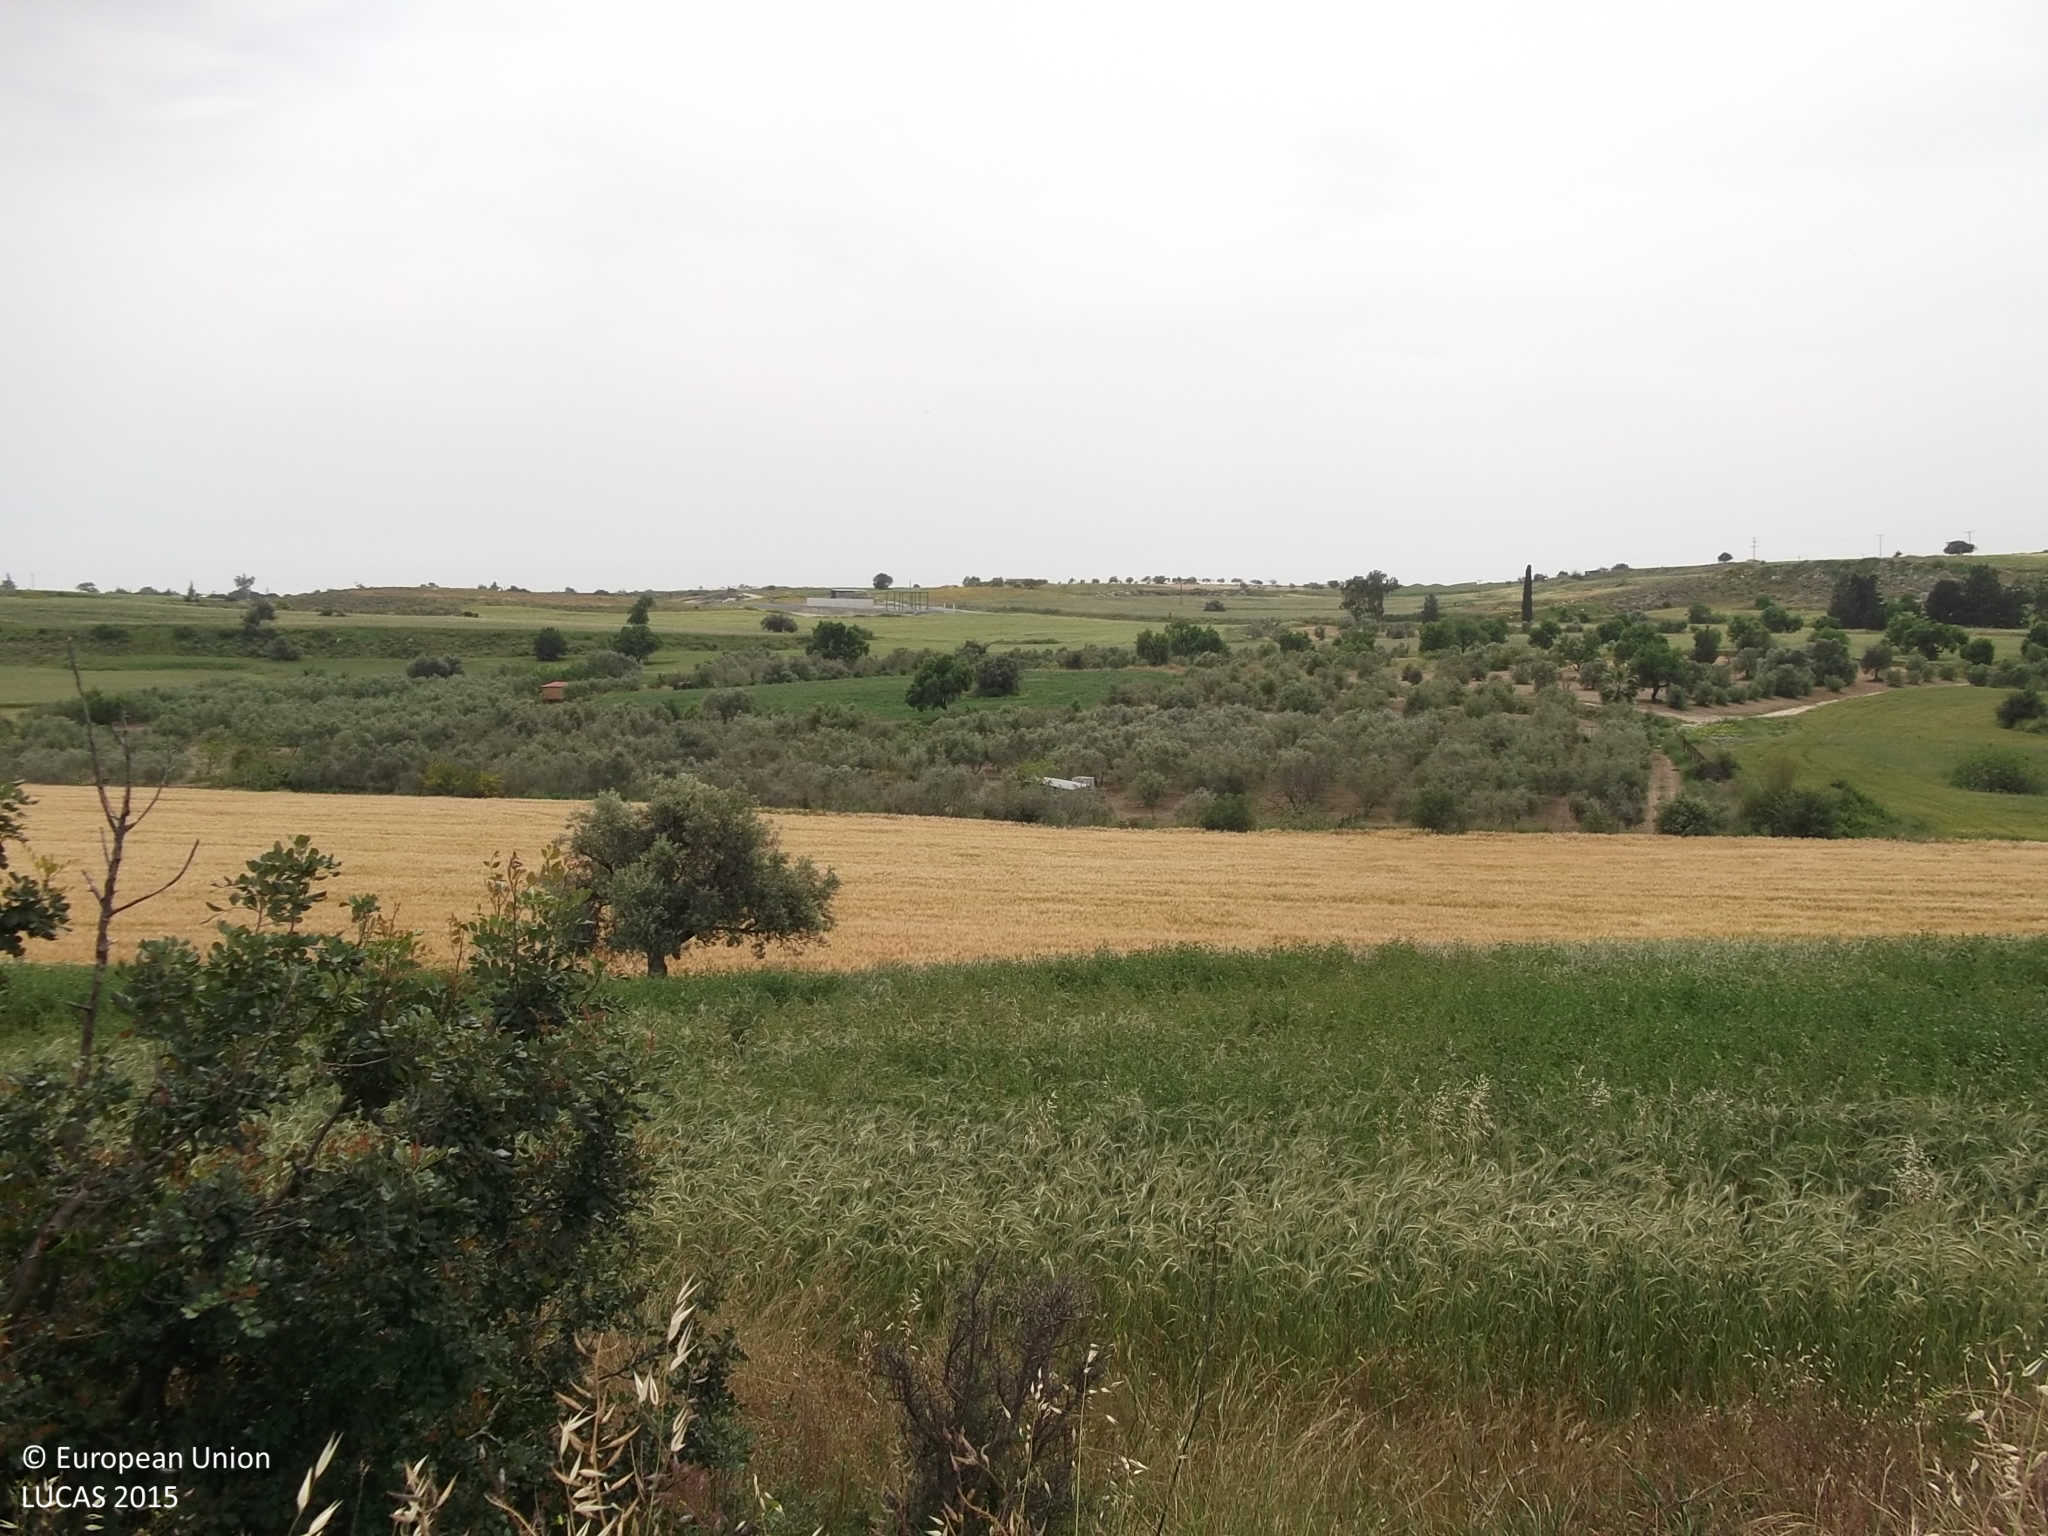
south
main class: Grassland
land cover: Spontaneously vegetated surfaces
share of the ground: > 75 %
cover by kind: herbaceous plants 85 %, unconsolidated bare surface 15 %
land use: Semi-natural and natural areas not in use
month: April
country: CY
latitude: 34.8415
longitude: 33.4694
